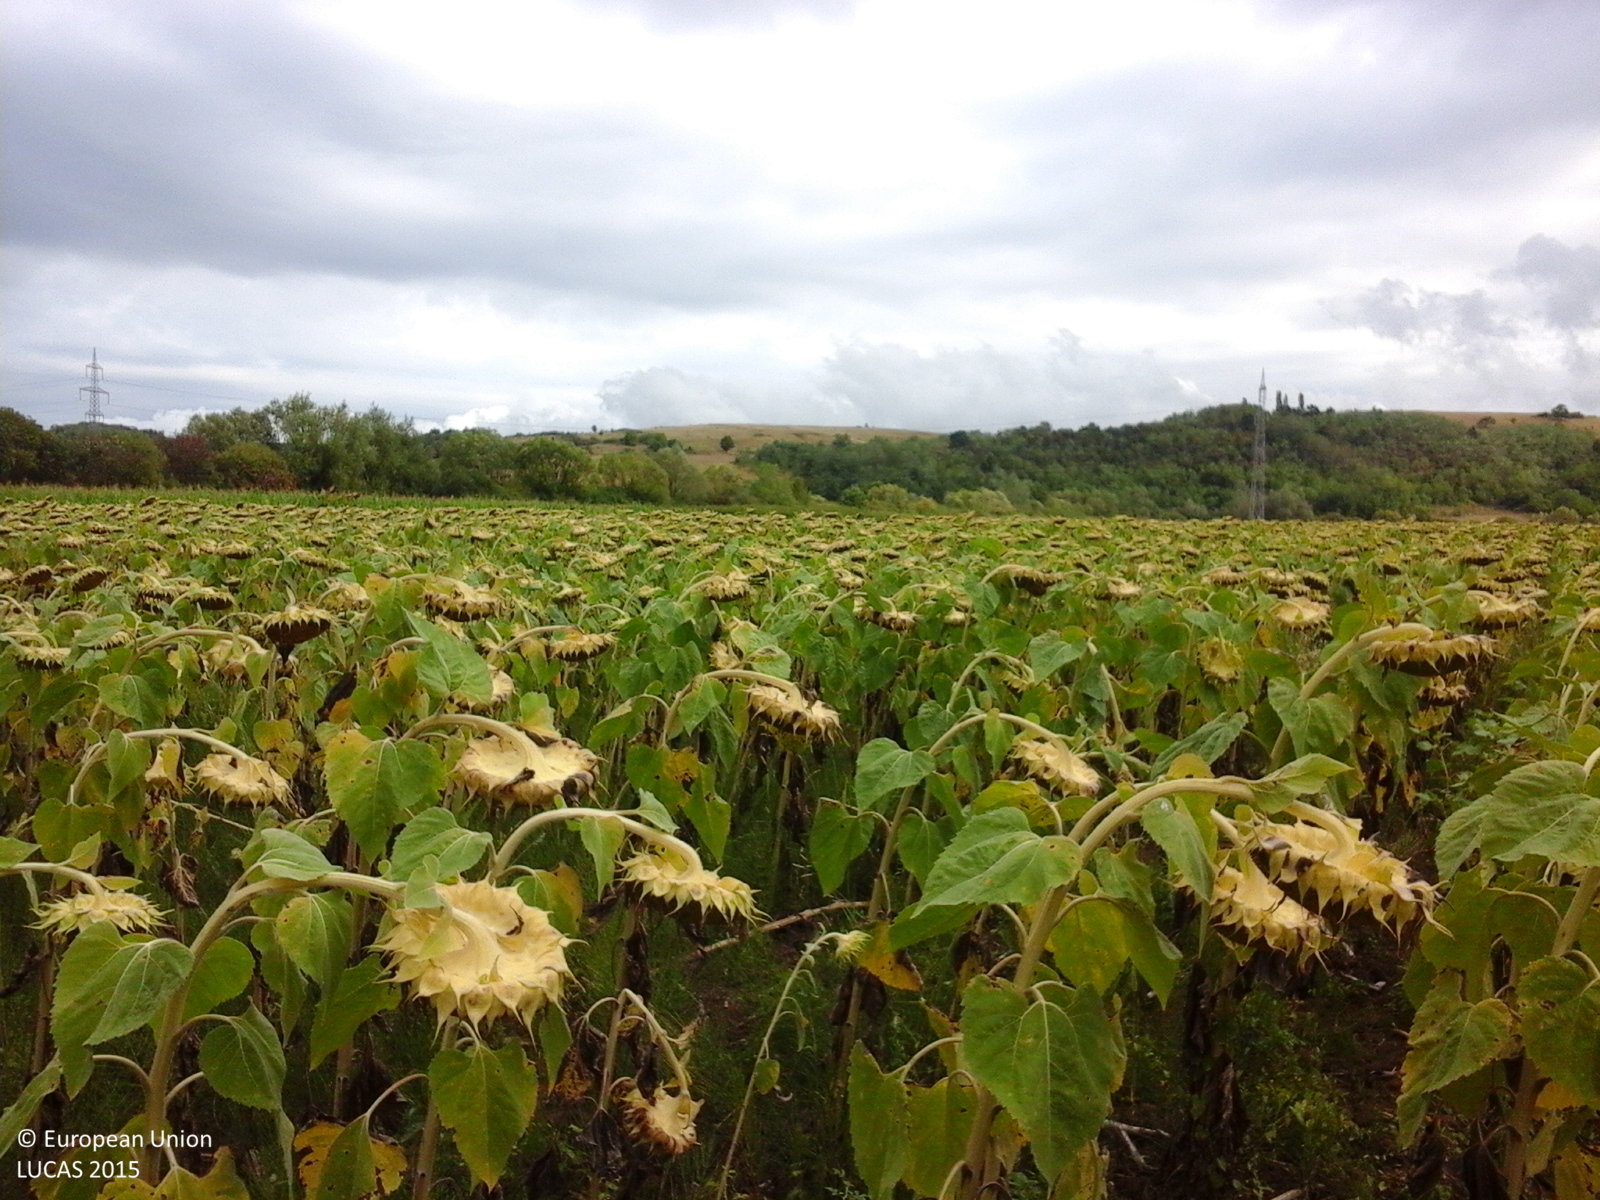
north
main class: Cropland
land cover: Sunflower
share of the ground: > 75 %
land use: Agriculture (excluding fallow land and kitchen gardens)
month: August
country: RO
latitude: 45.4389
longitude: 21.6543
